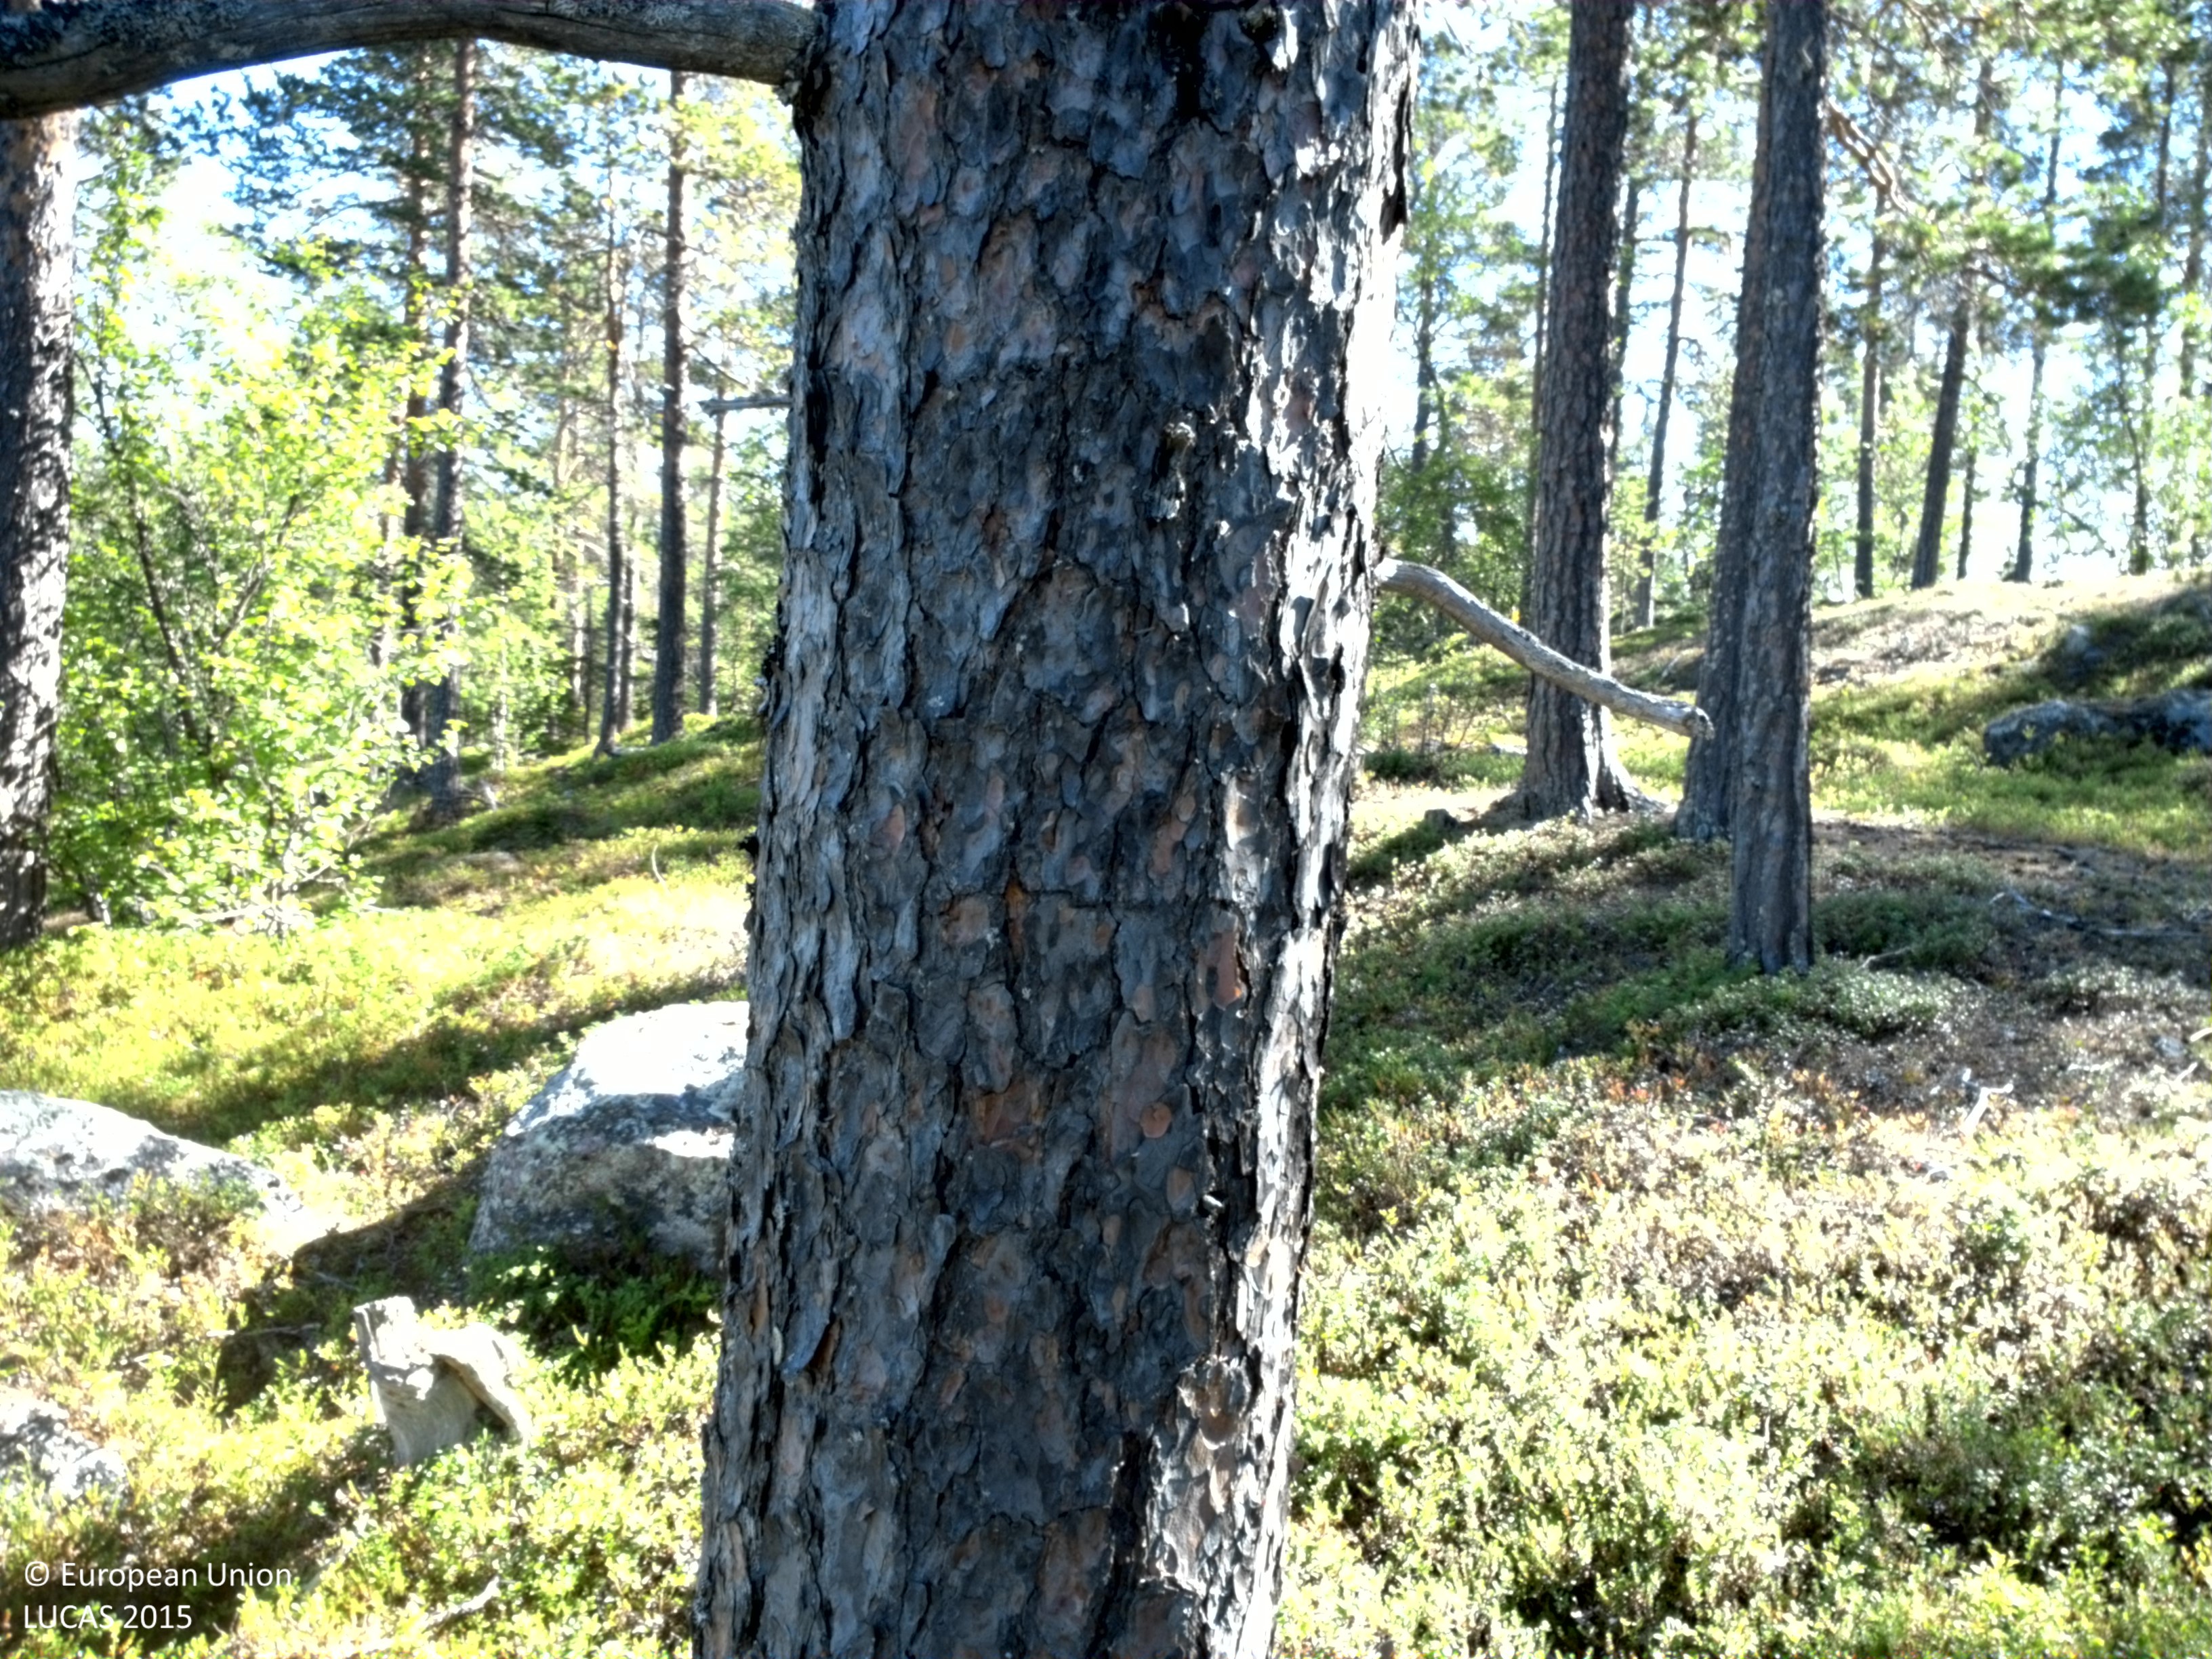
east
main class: Woodland
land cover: Pine dominated coniferous woodland
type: boreal forest
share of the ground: 25 - 50 %
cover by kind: shrubs 65 %, coniferous forest trees 25 %, broadleaved forest trees 5 %, consolidated bare surface 5 %
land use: Forestry
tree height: > 5 m
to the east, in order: Pine dominated coniferous woodland; Spruce dominated coniferous woodland; Pine dominated coniferous woodland; Pine dominated mixed woodland; Rivers and streams; Spruce dominated mixed woodland; Pine dominated coniferous woodland; Other mixed woodland
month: August
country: SE
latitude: 66.6333
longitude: 18.7393
